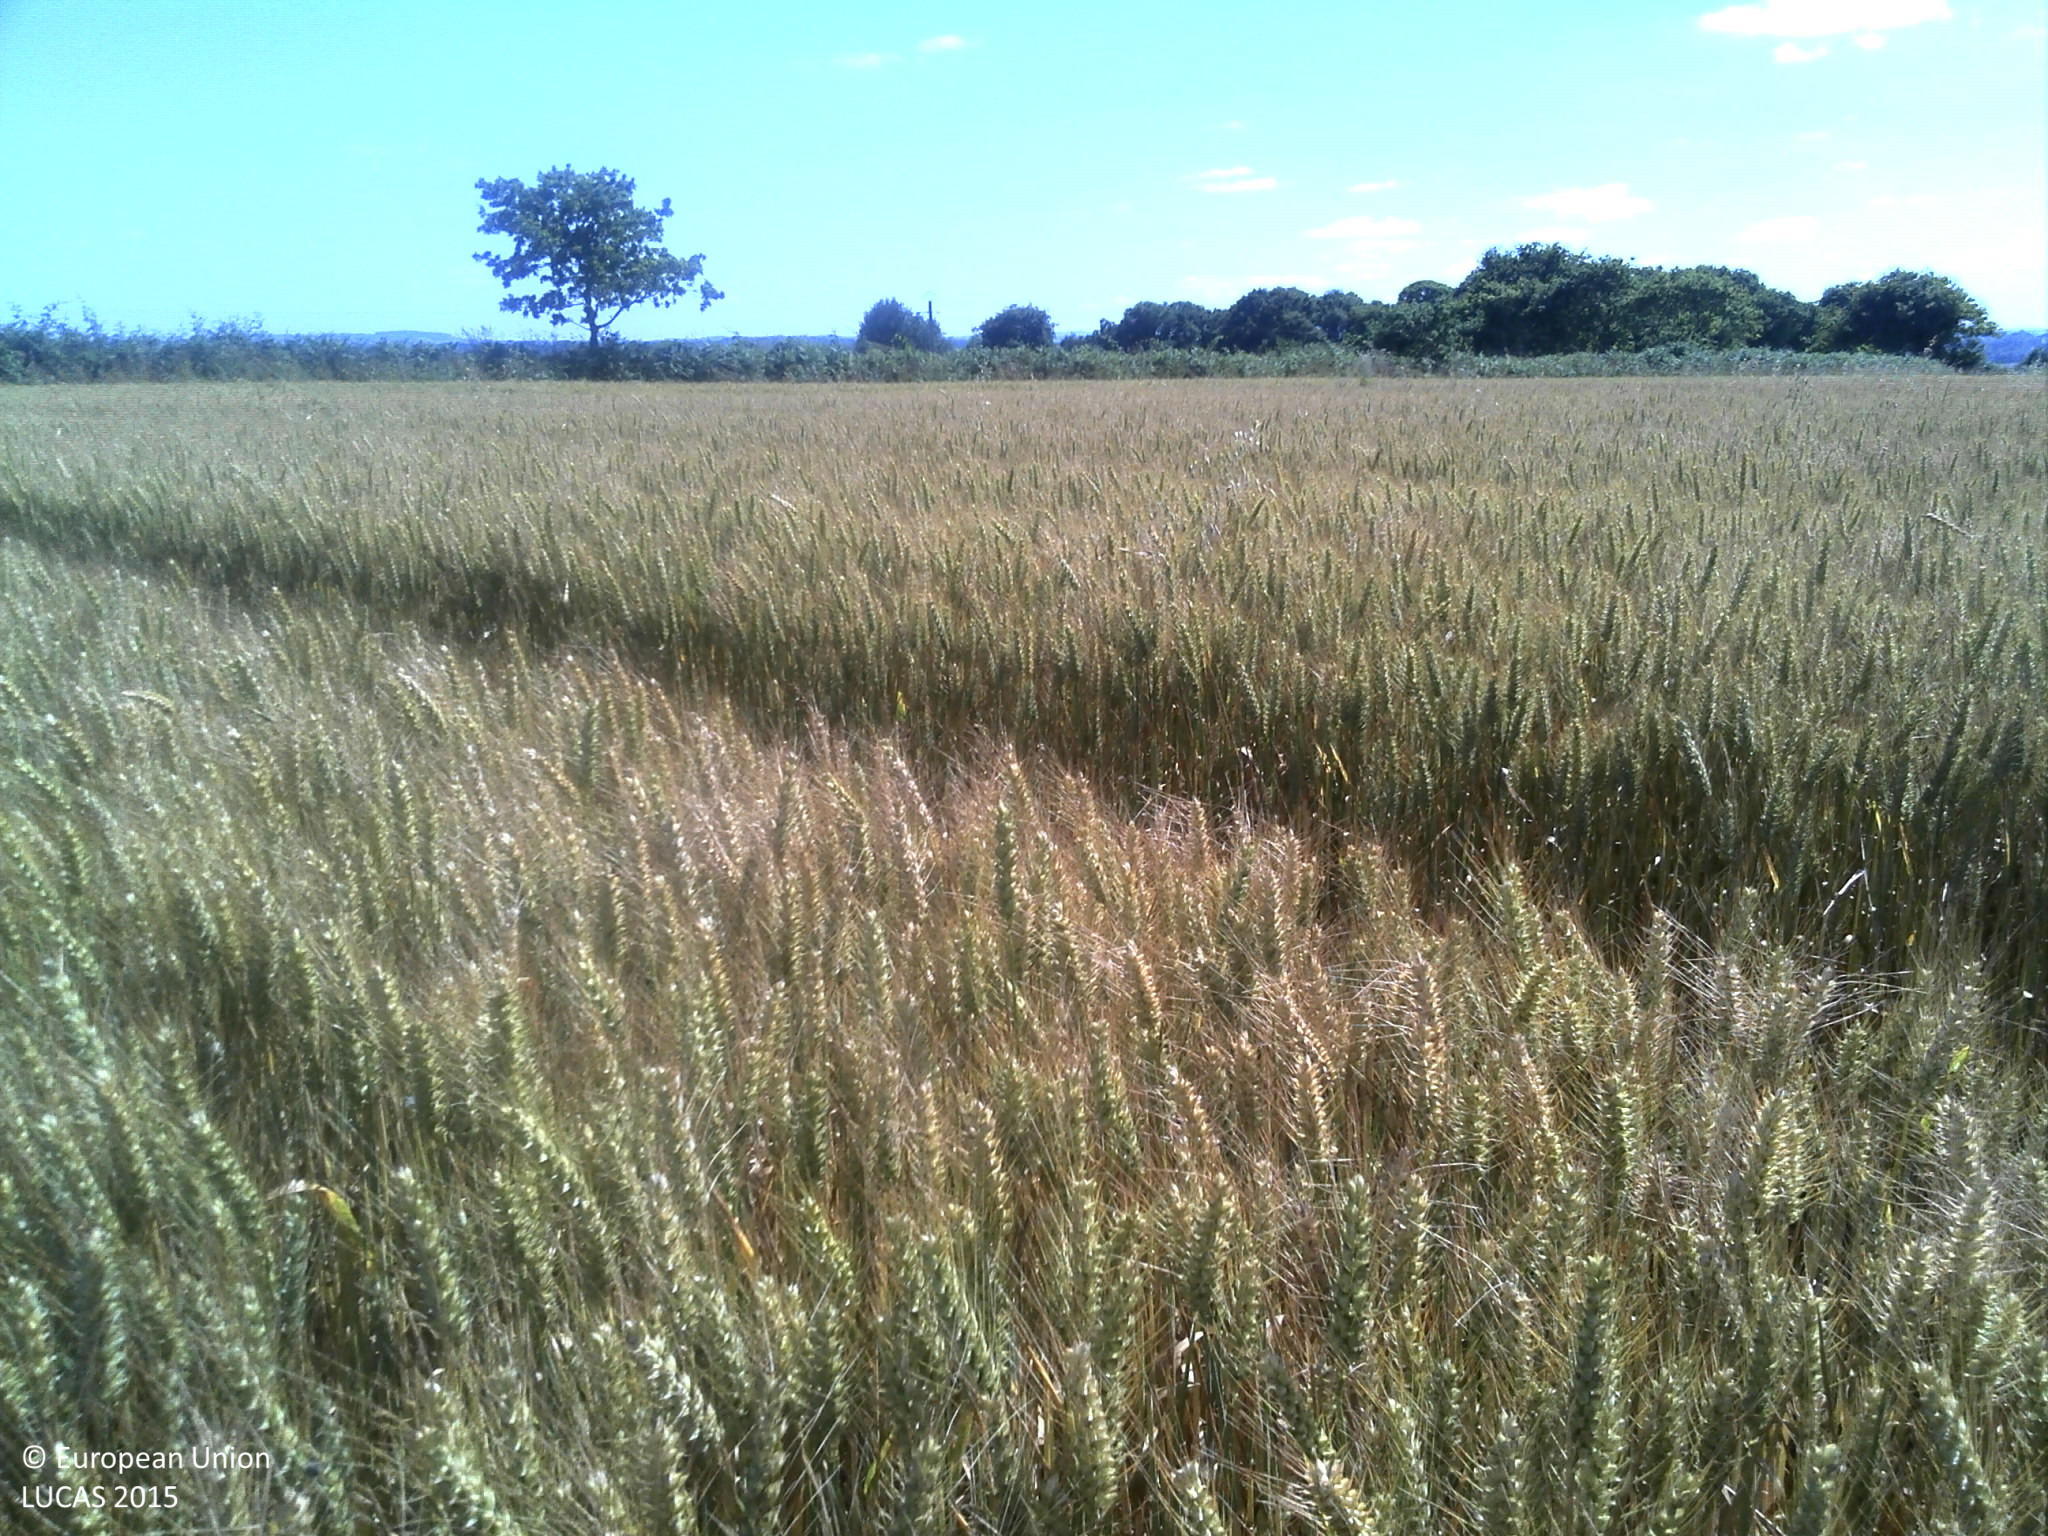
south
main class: Cropland
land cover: Common wheat
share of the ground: > 75 %
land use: Agriculture (excluding fallow land and kitchen gardens)
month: July
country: FR
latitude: 48.6311
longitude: -3.7756
